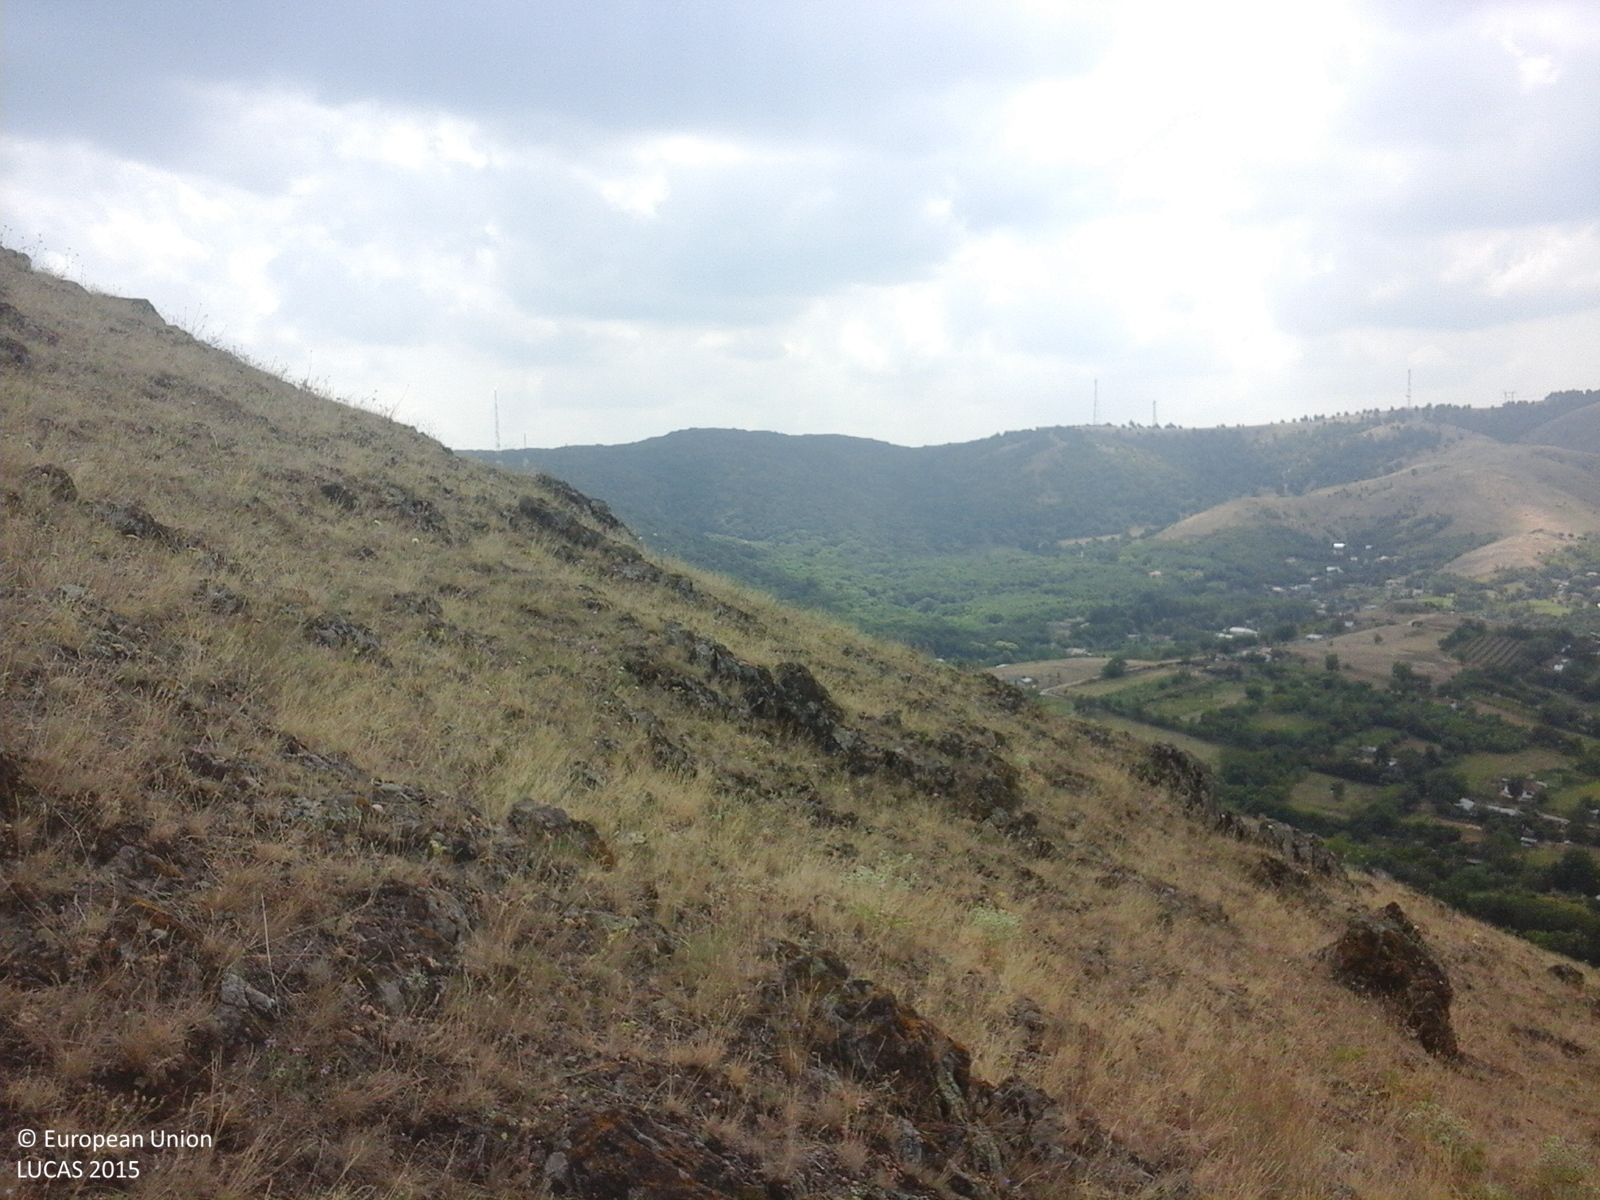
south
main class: Grassland
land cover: Grassland without tree/shrub cover
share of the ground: > 75 %
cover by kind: herbaceous plants 85 %, consolidated bare surface 15 %
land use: Semi-natural and natural areas not in use
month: July
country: RO
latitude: 45.1815
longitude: 28.4944
